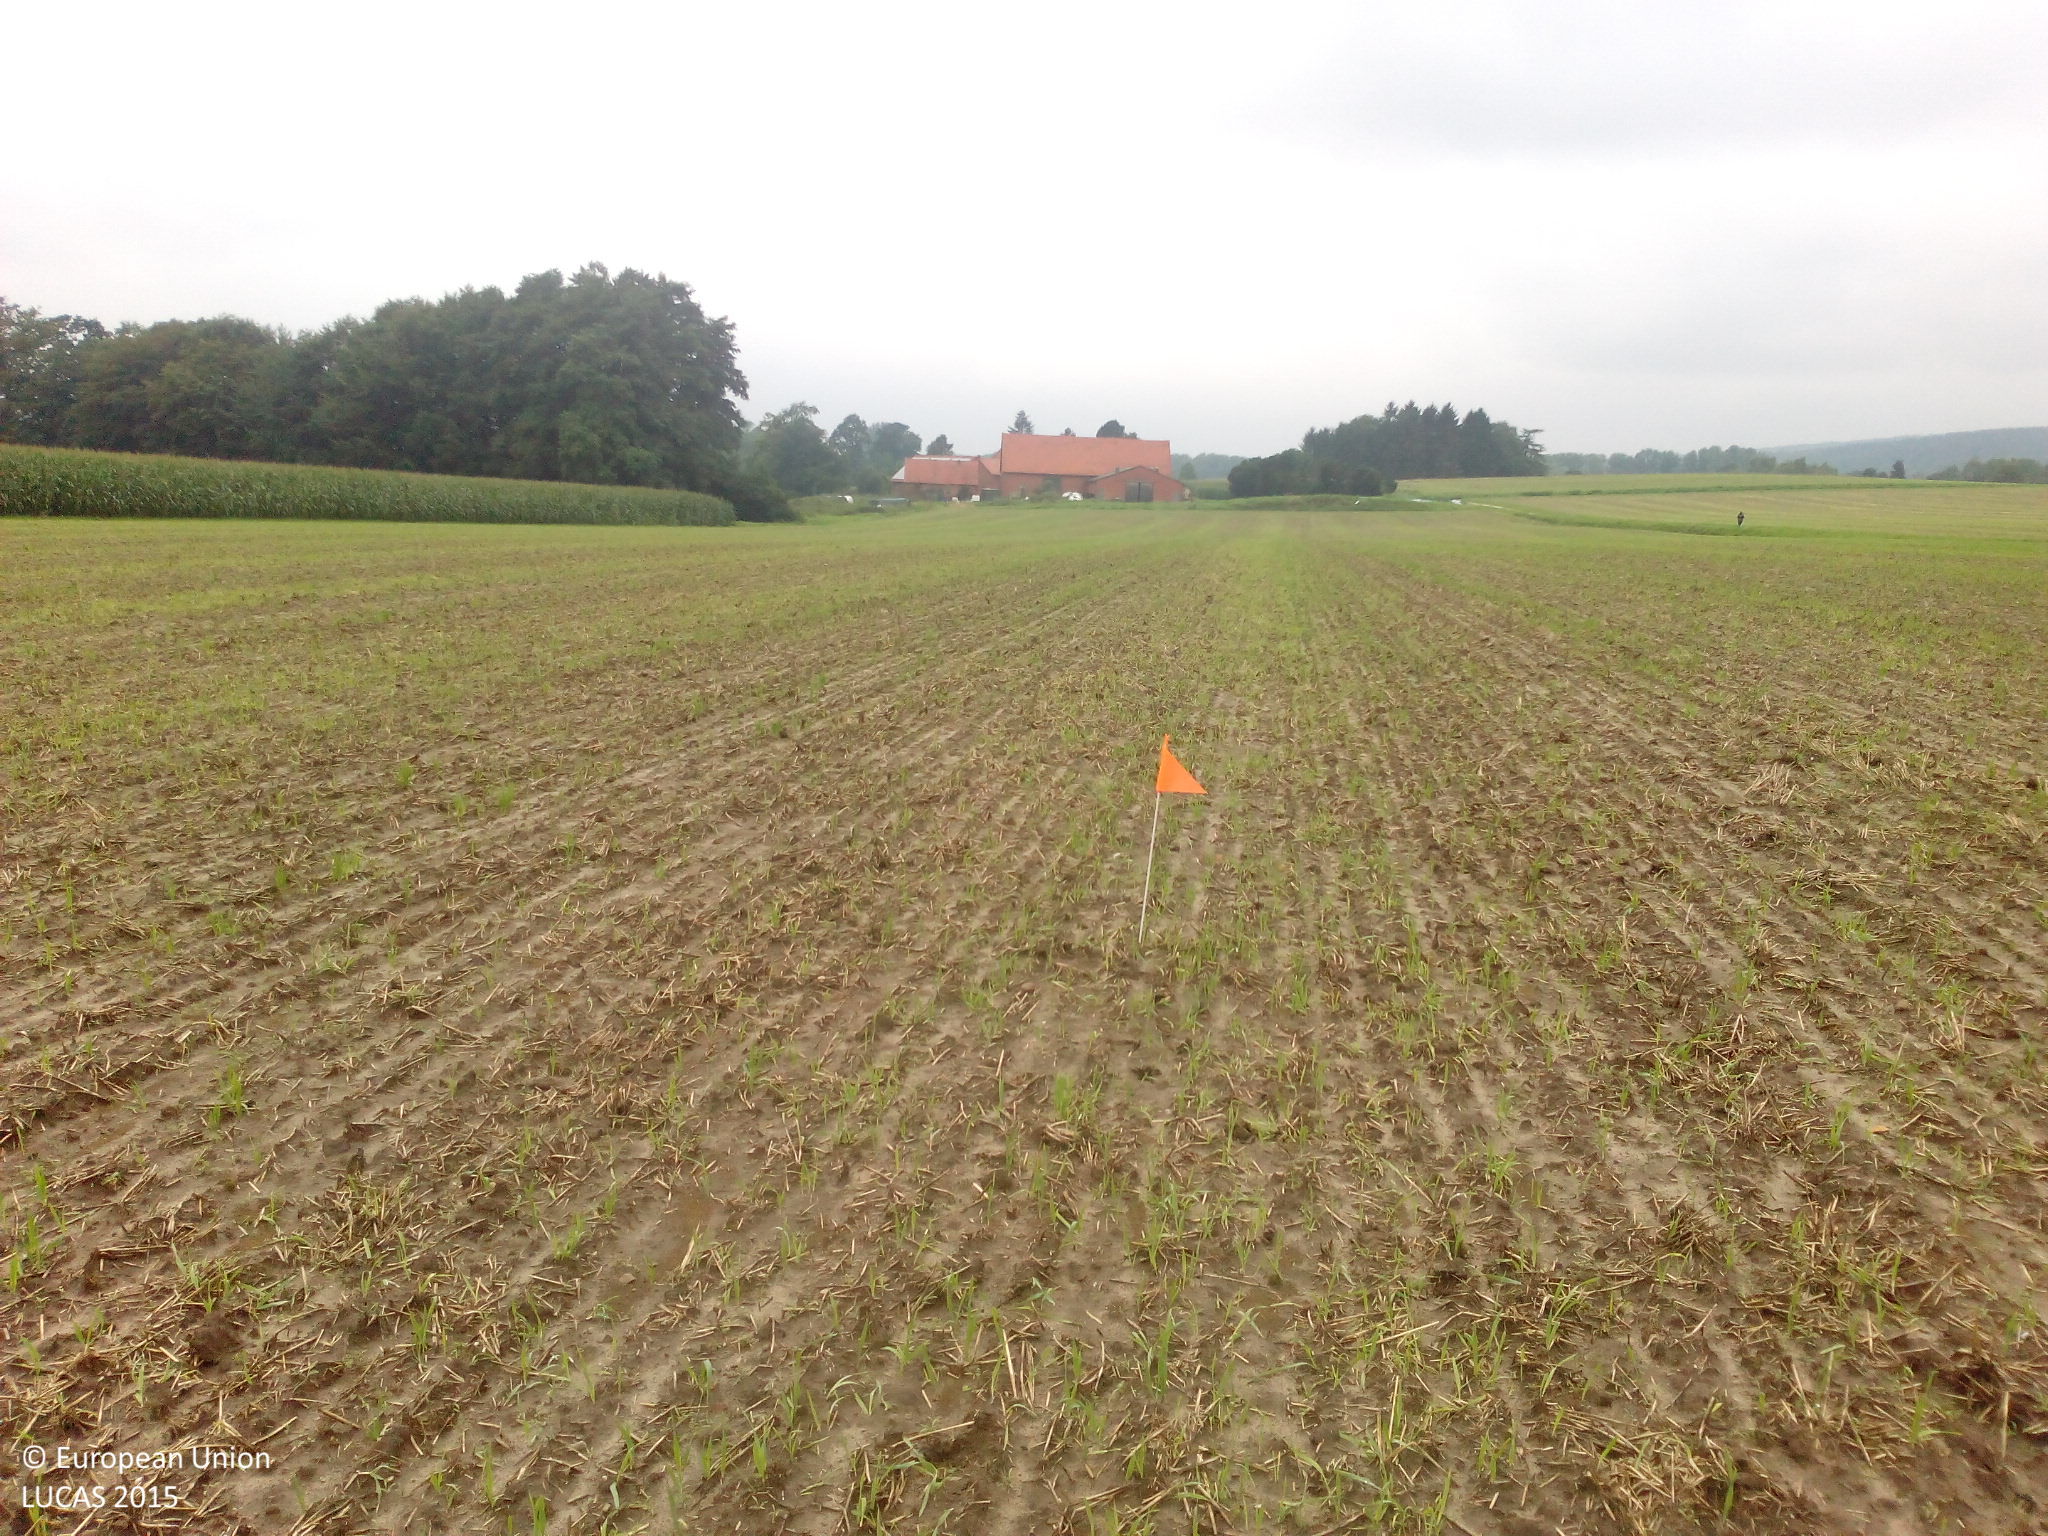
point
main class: Grassland
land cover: Spontaneously vegetated surfaces
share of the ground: 25 - 50 %
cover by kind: unconsolidated bare surface 75 %, herbaceous plants 25 %
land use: Agriculture (excluding fallow land and kitchen gardens)
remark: Harvested field
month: August
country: DE
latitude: 52.1454
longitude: 8.0276
